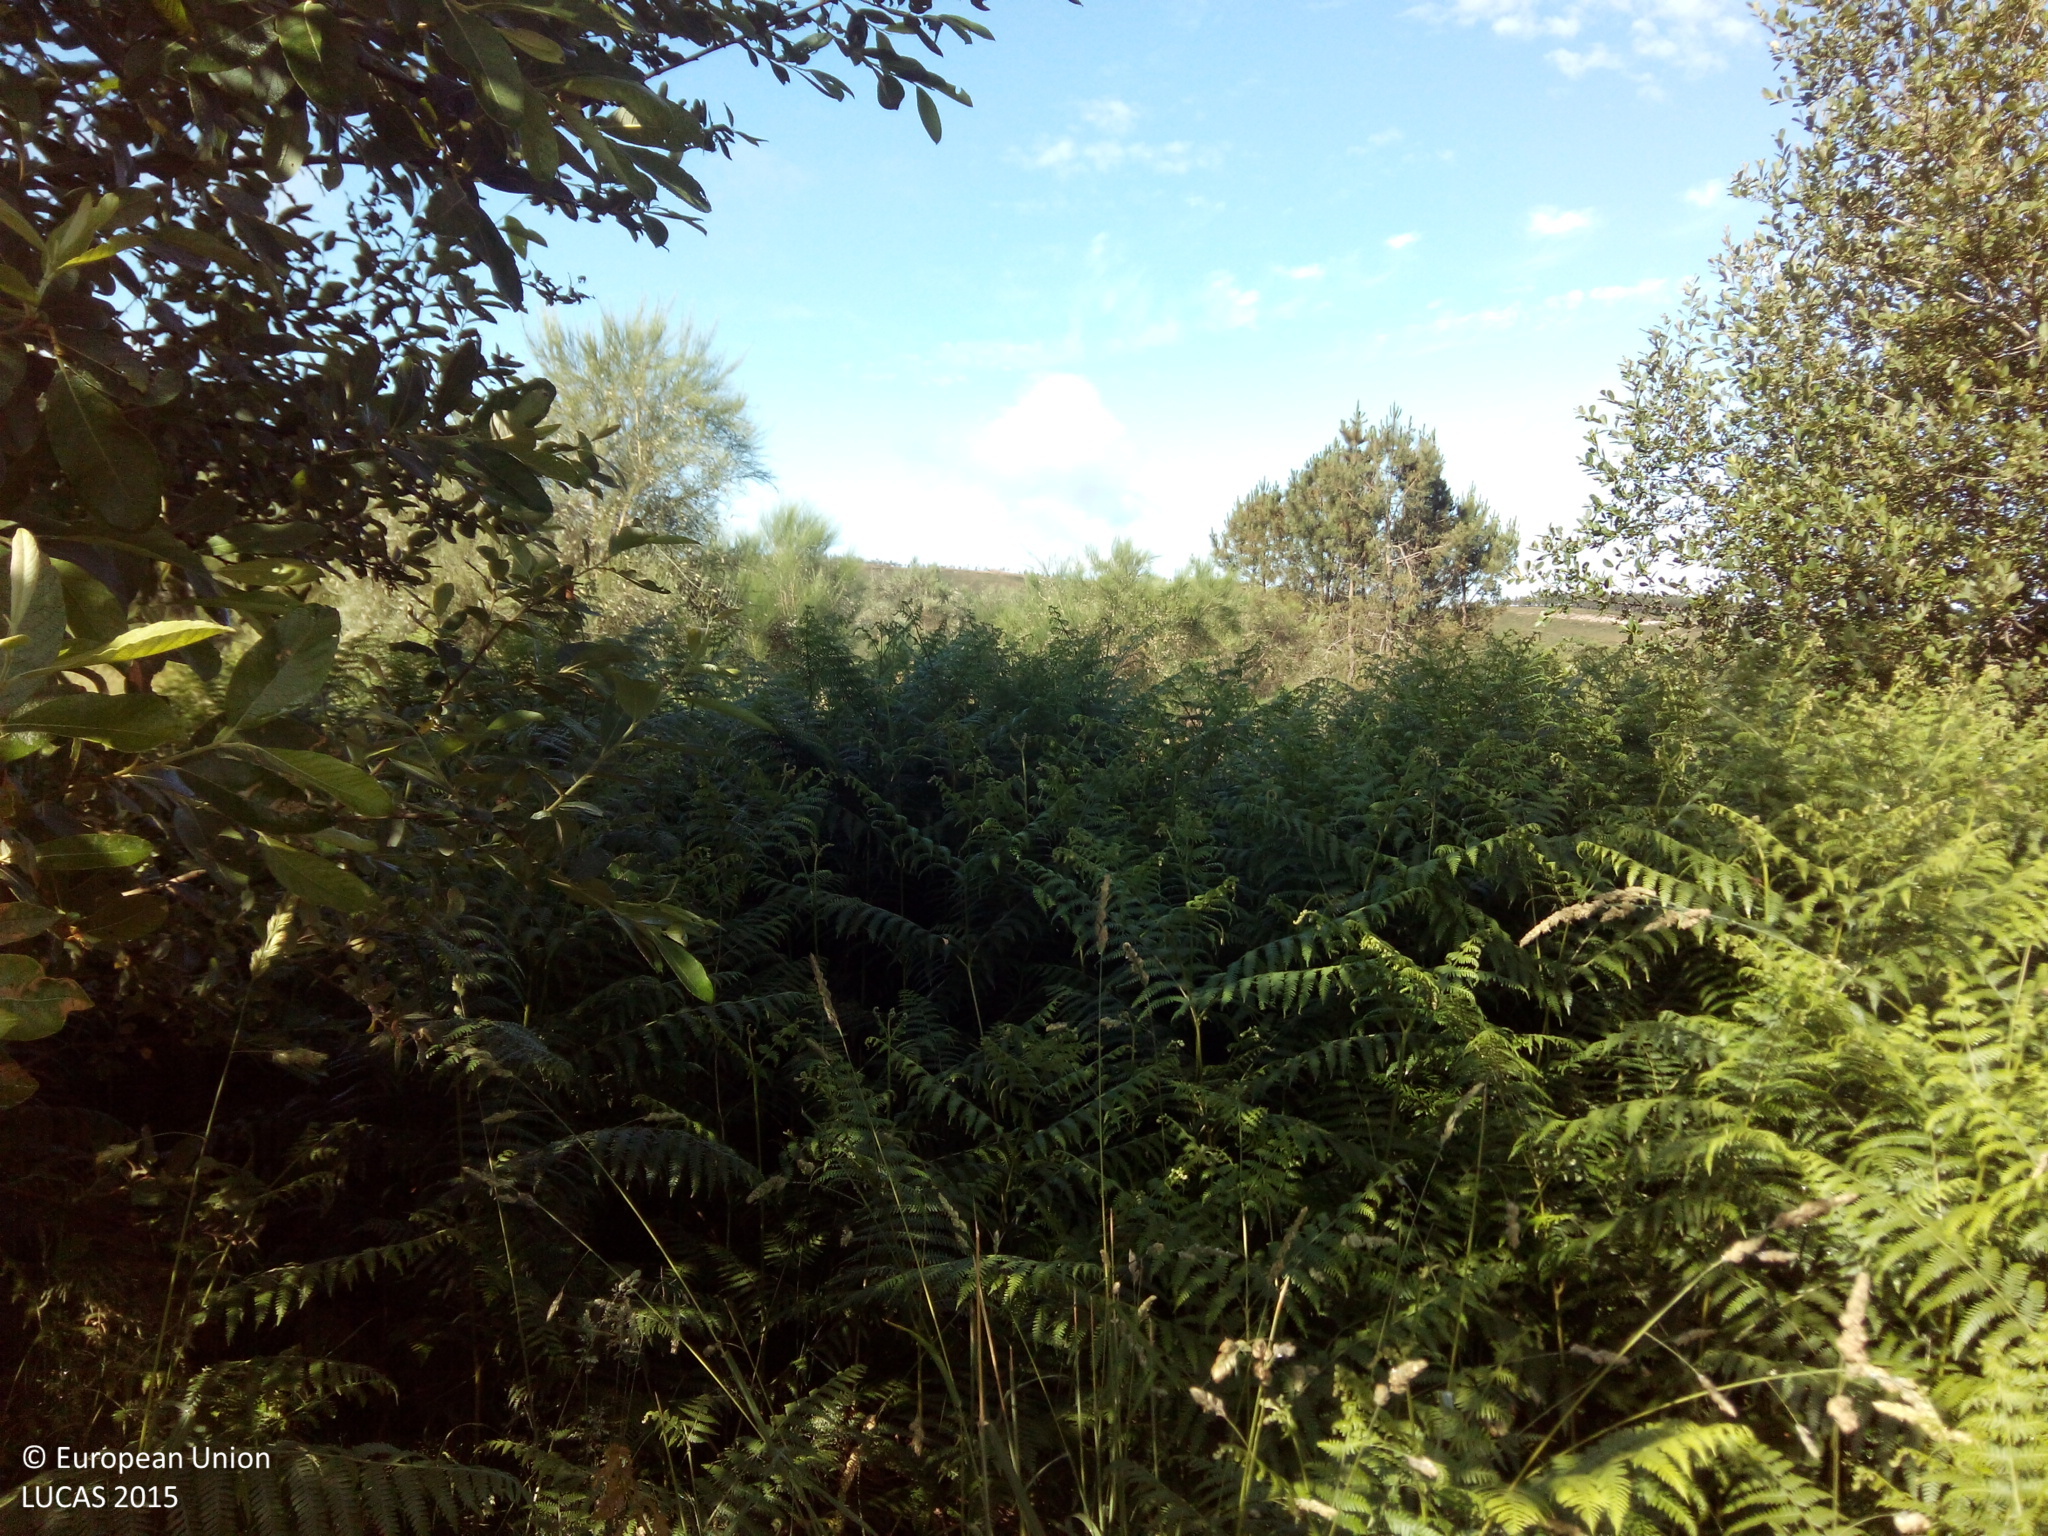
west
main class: Grassland
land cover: Grassland with sparse tree/shrub cover
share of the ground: > 75 %
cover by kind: herbaceous plants 95 %, coniferous forest trees 5 %
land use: Abandoned areas
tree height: < 5 m
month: July
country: ES
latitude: 42.3222
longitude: -8.2781
